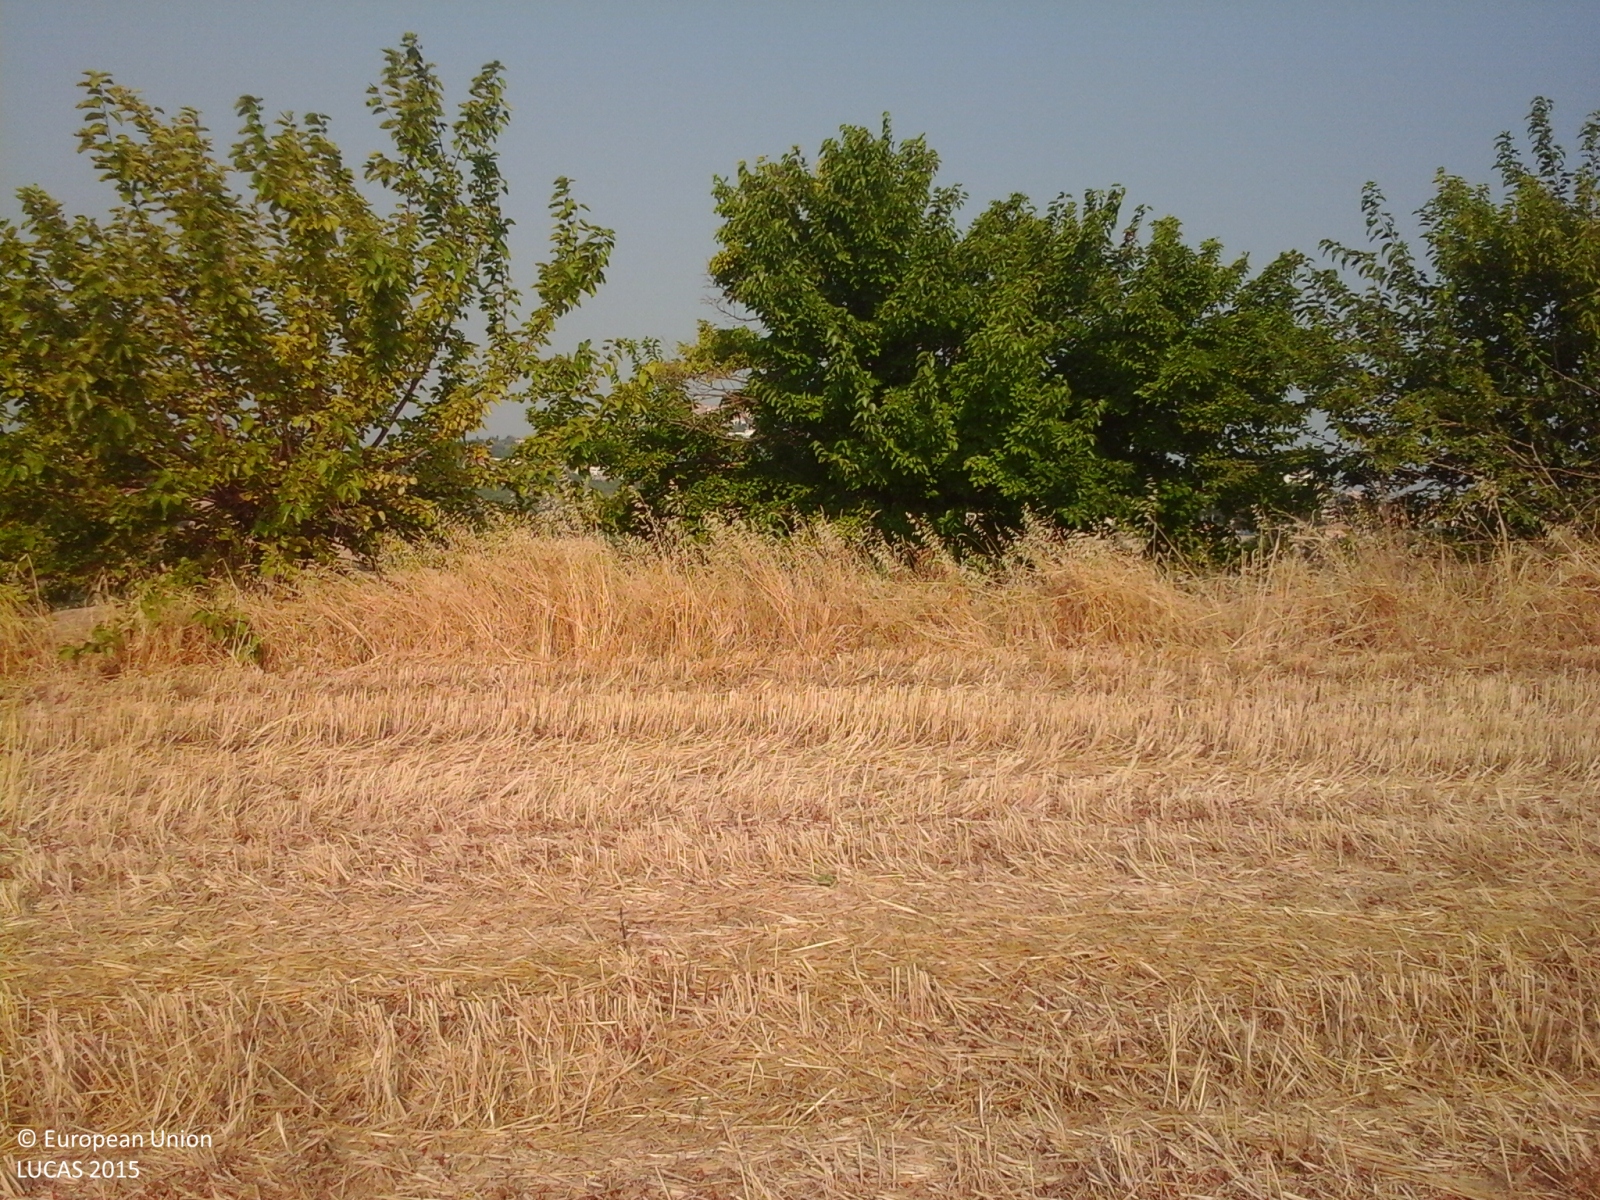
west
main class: Cropland
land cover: Durum wheat
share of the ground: > 75 %
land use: Agriculture (excluding fallow land and kitchen gardens)
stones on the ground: < 10 %
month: August
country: IT
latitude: 42.5172
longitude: 14.0899
